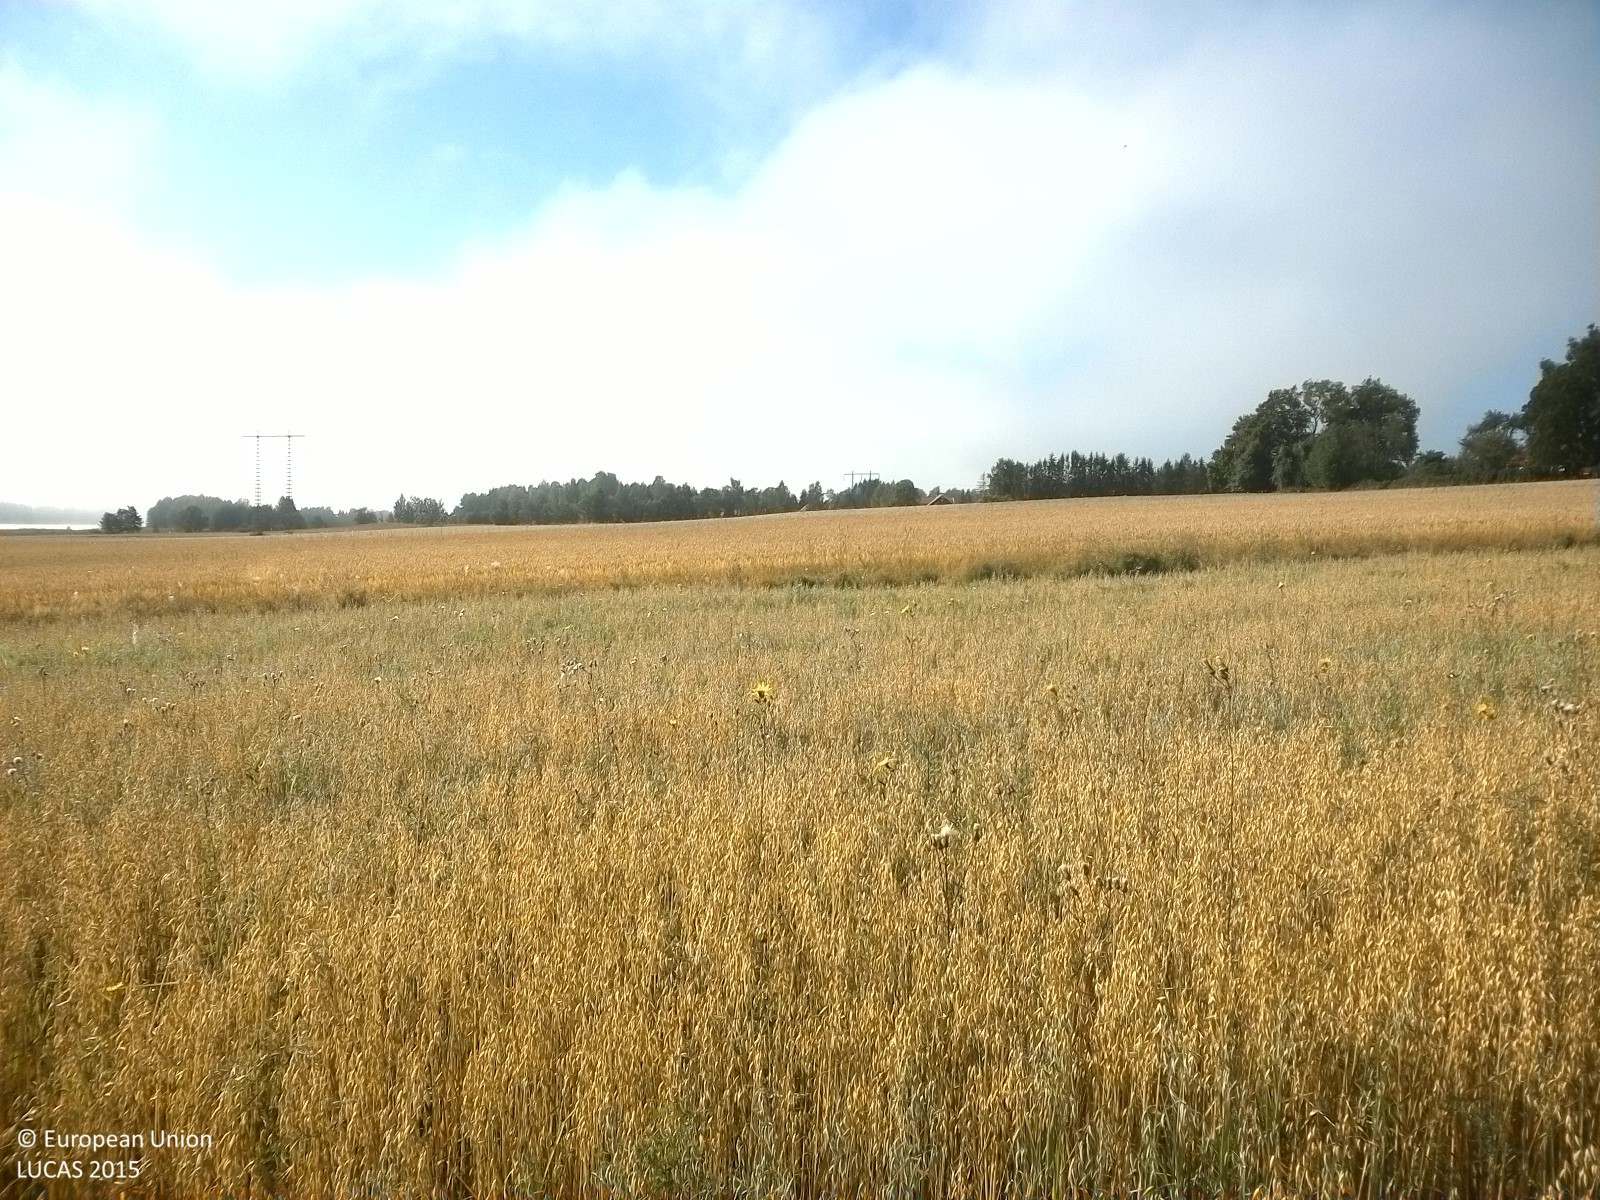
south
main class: Cropland
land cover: Oats
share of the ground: > 75 %
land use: Agriculture (excluding fallow land and kitchen gardens)
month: August
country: SE
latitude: 59.3819
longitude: 15.1841
